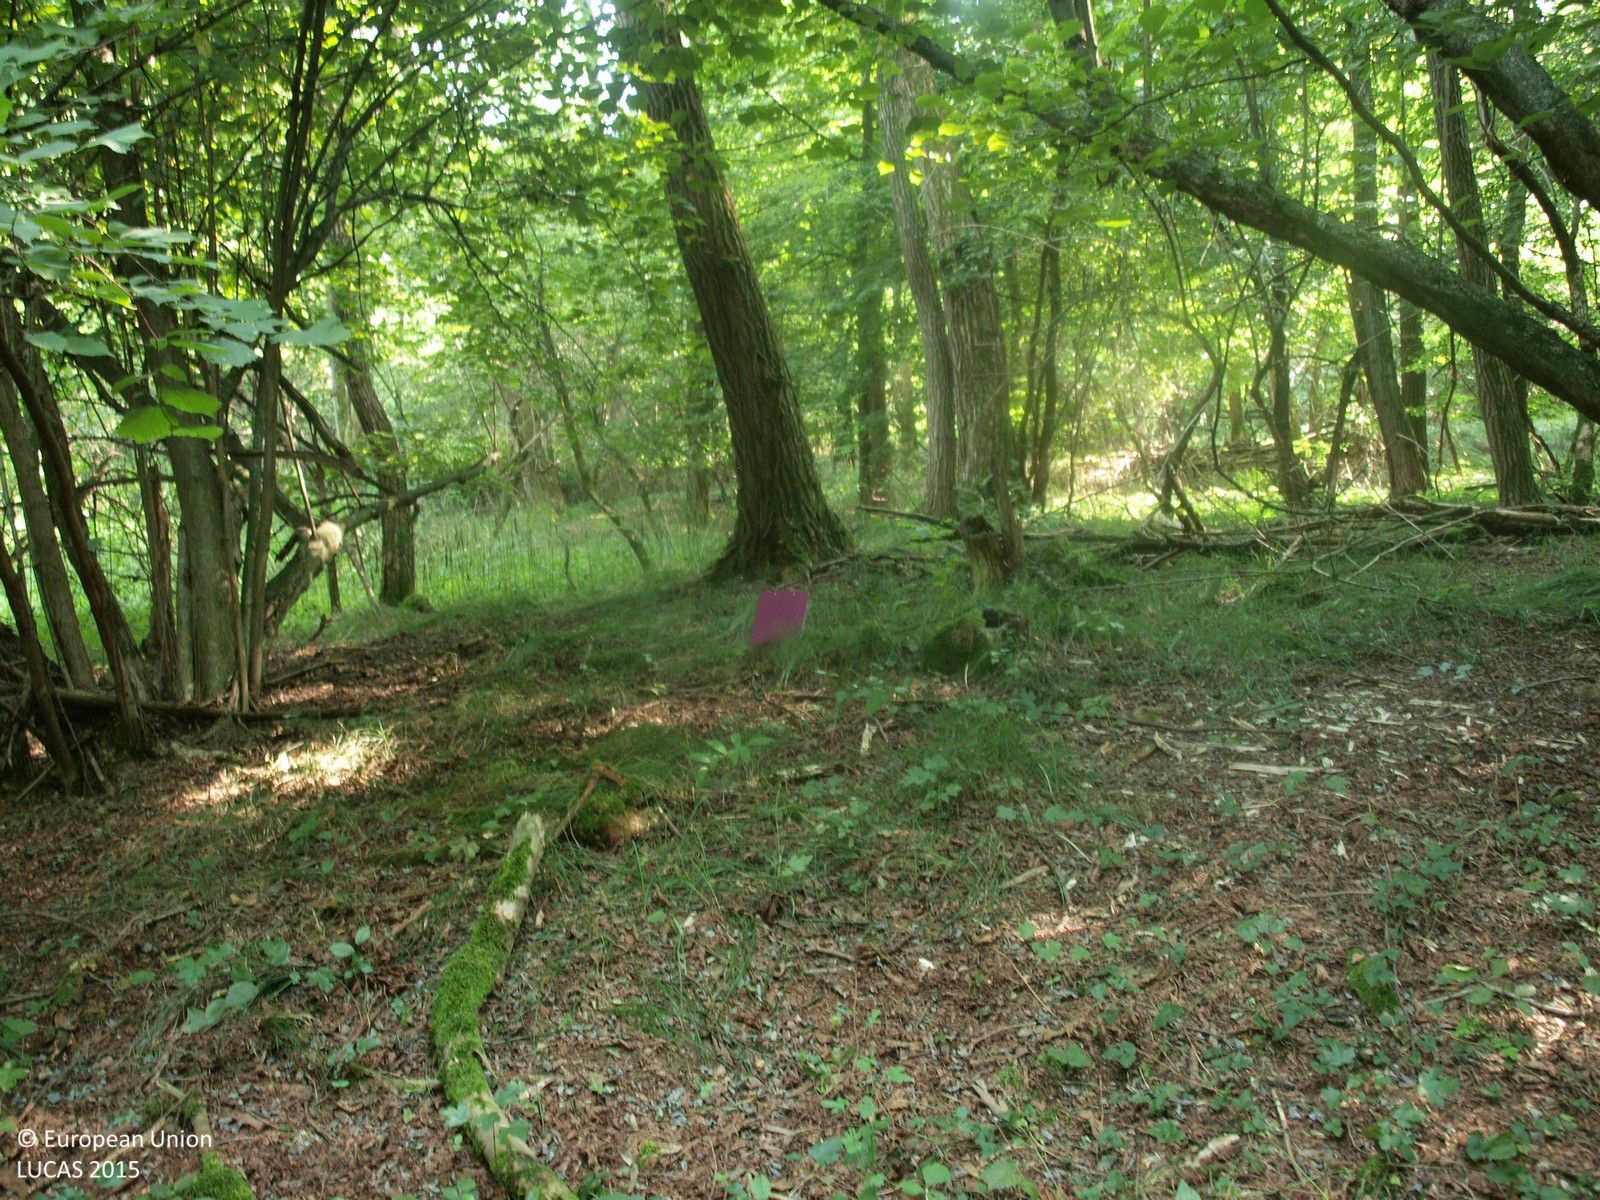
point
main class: Woodland
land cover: Broadleaved woodland
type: mesophytic deciduous forest
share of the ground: > 75 %
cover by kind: broadleaved forest trees 100 %
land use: Forestry
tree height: > 5 m
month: August
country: HR
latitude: 45.9621
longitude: 16.6713
